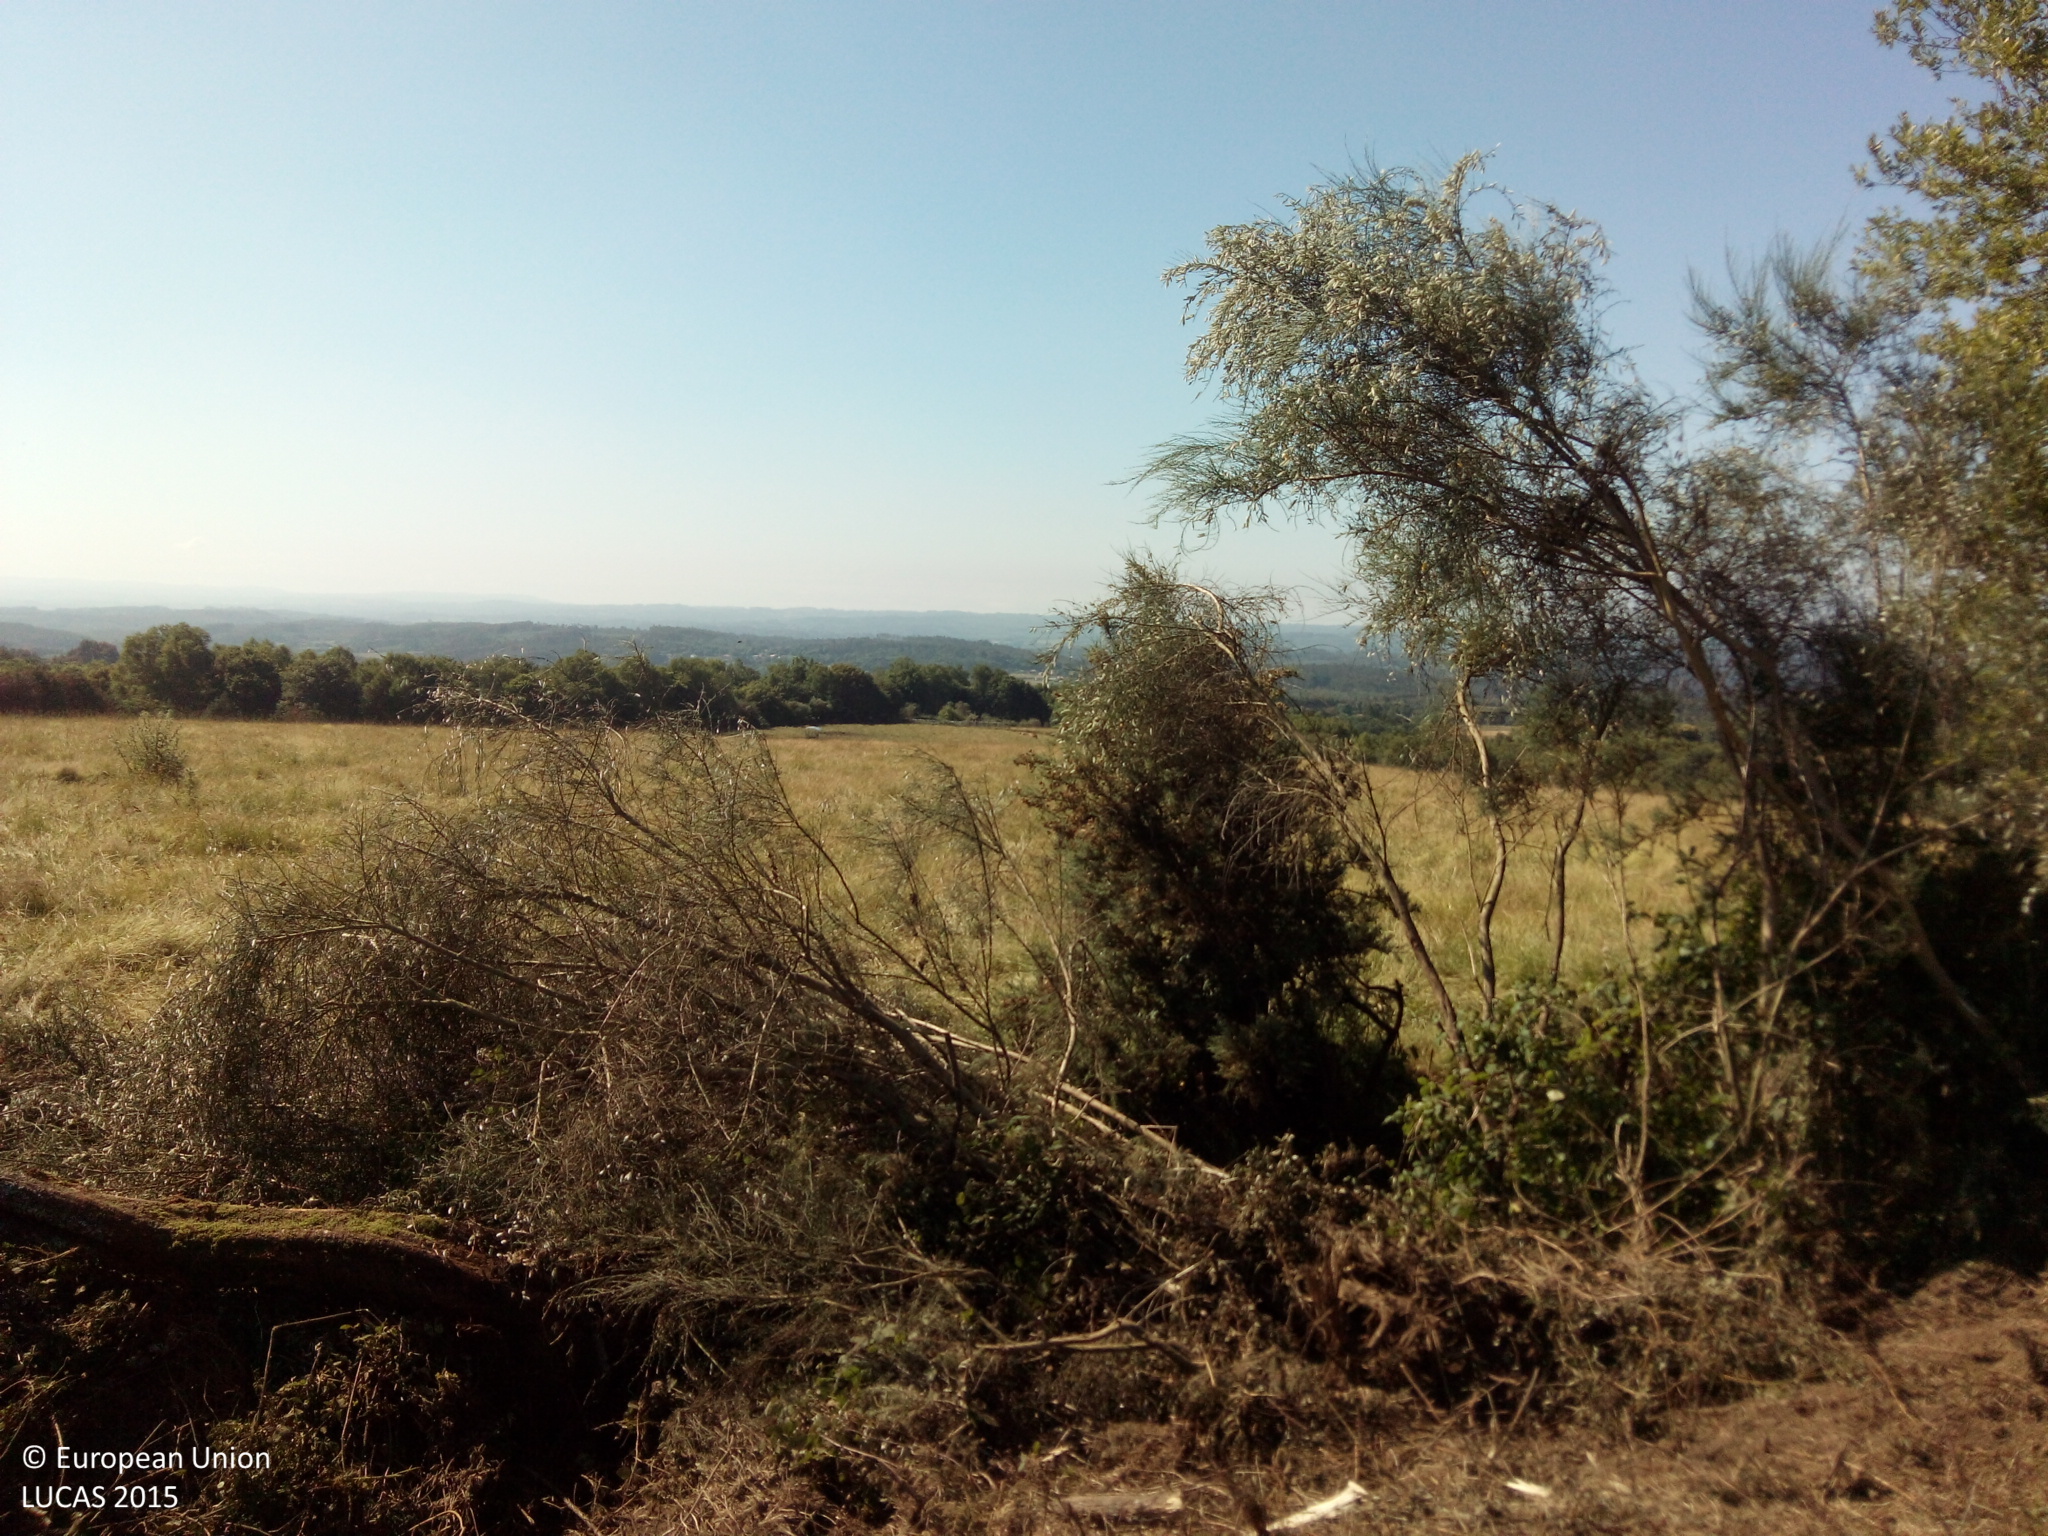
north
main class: Woodland
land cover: Pine dominated coniferous woodland
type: hemiboreal forest and nemoral coniferous forest and mixed broadleaved-coniferous forest
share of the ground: 25 - 50 %
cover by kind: coniferous forest trees 50 %, shrubs 30 %, herbaceous plants 20 %
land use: Forestry
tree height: < 5 m
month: June
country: ES
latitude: 42.9939
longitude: -8.0352
